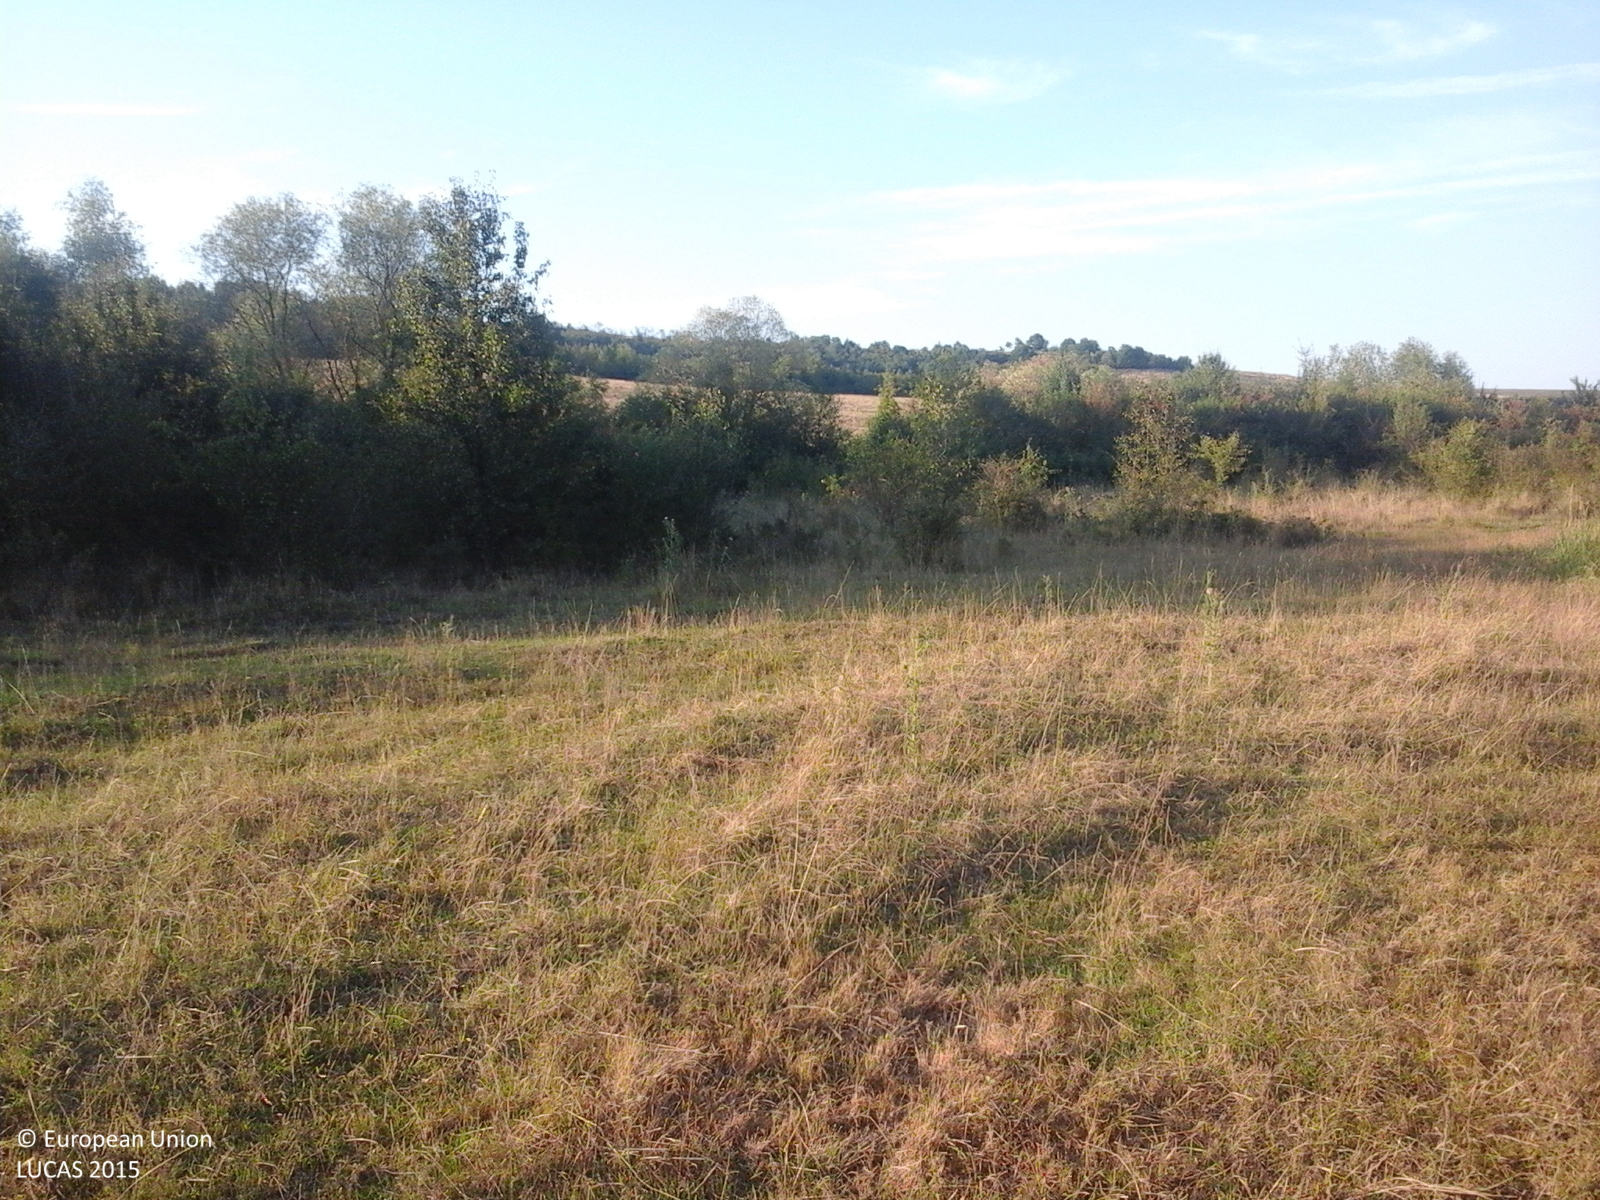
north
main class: Grassland
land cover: Grassland without tree/shrub cover
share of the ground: > 75 %
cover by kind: herbaceous plants 100 %
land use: Agriculture (excluding fallow land and kitchen gardens)
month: August
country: RO
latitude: 45.8822
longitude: 21.5936
